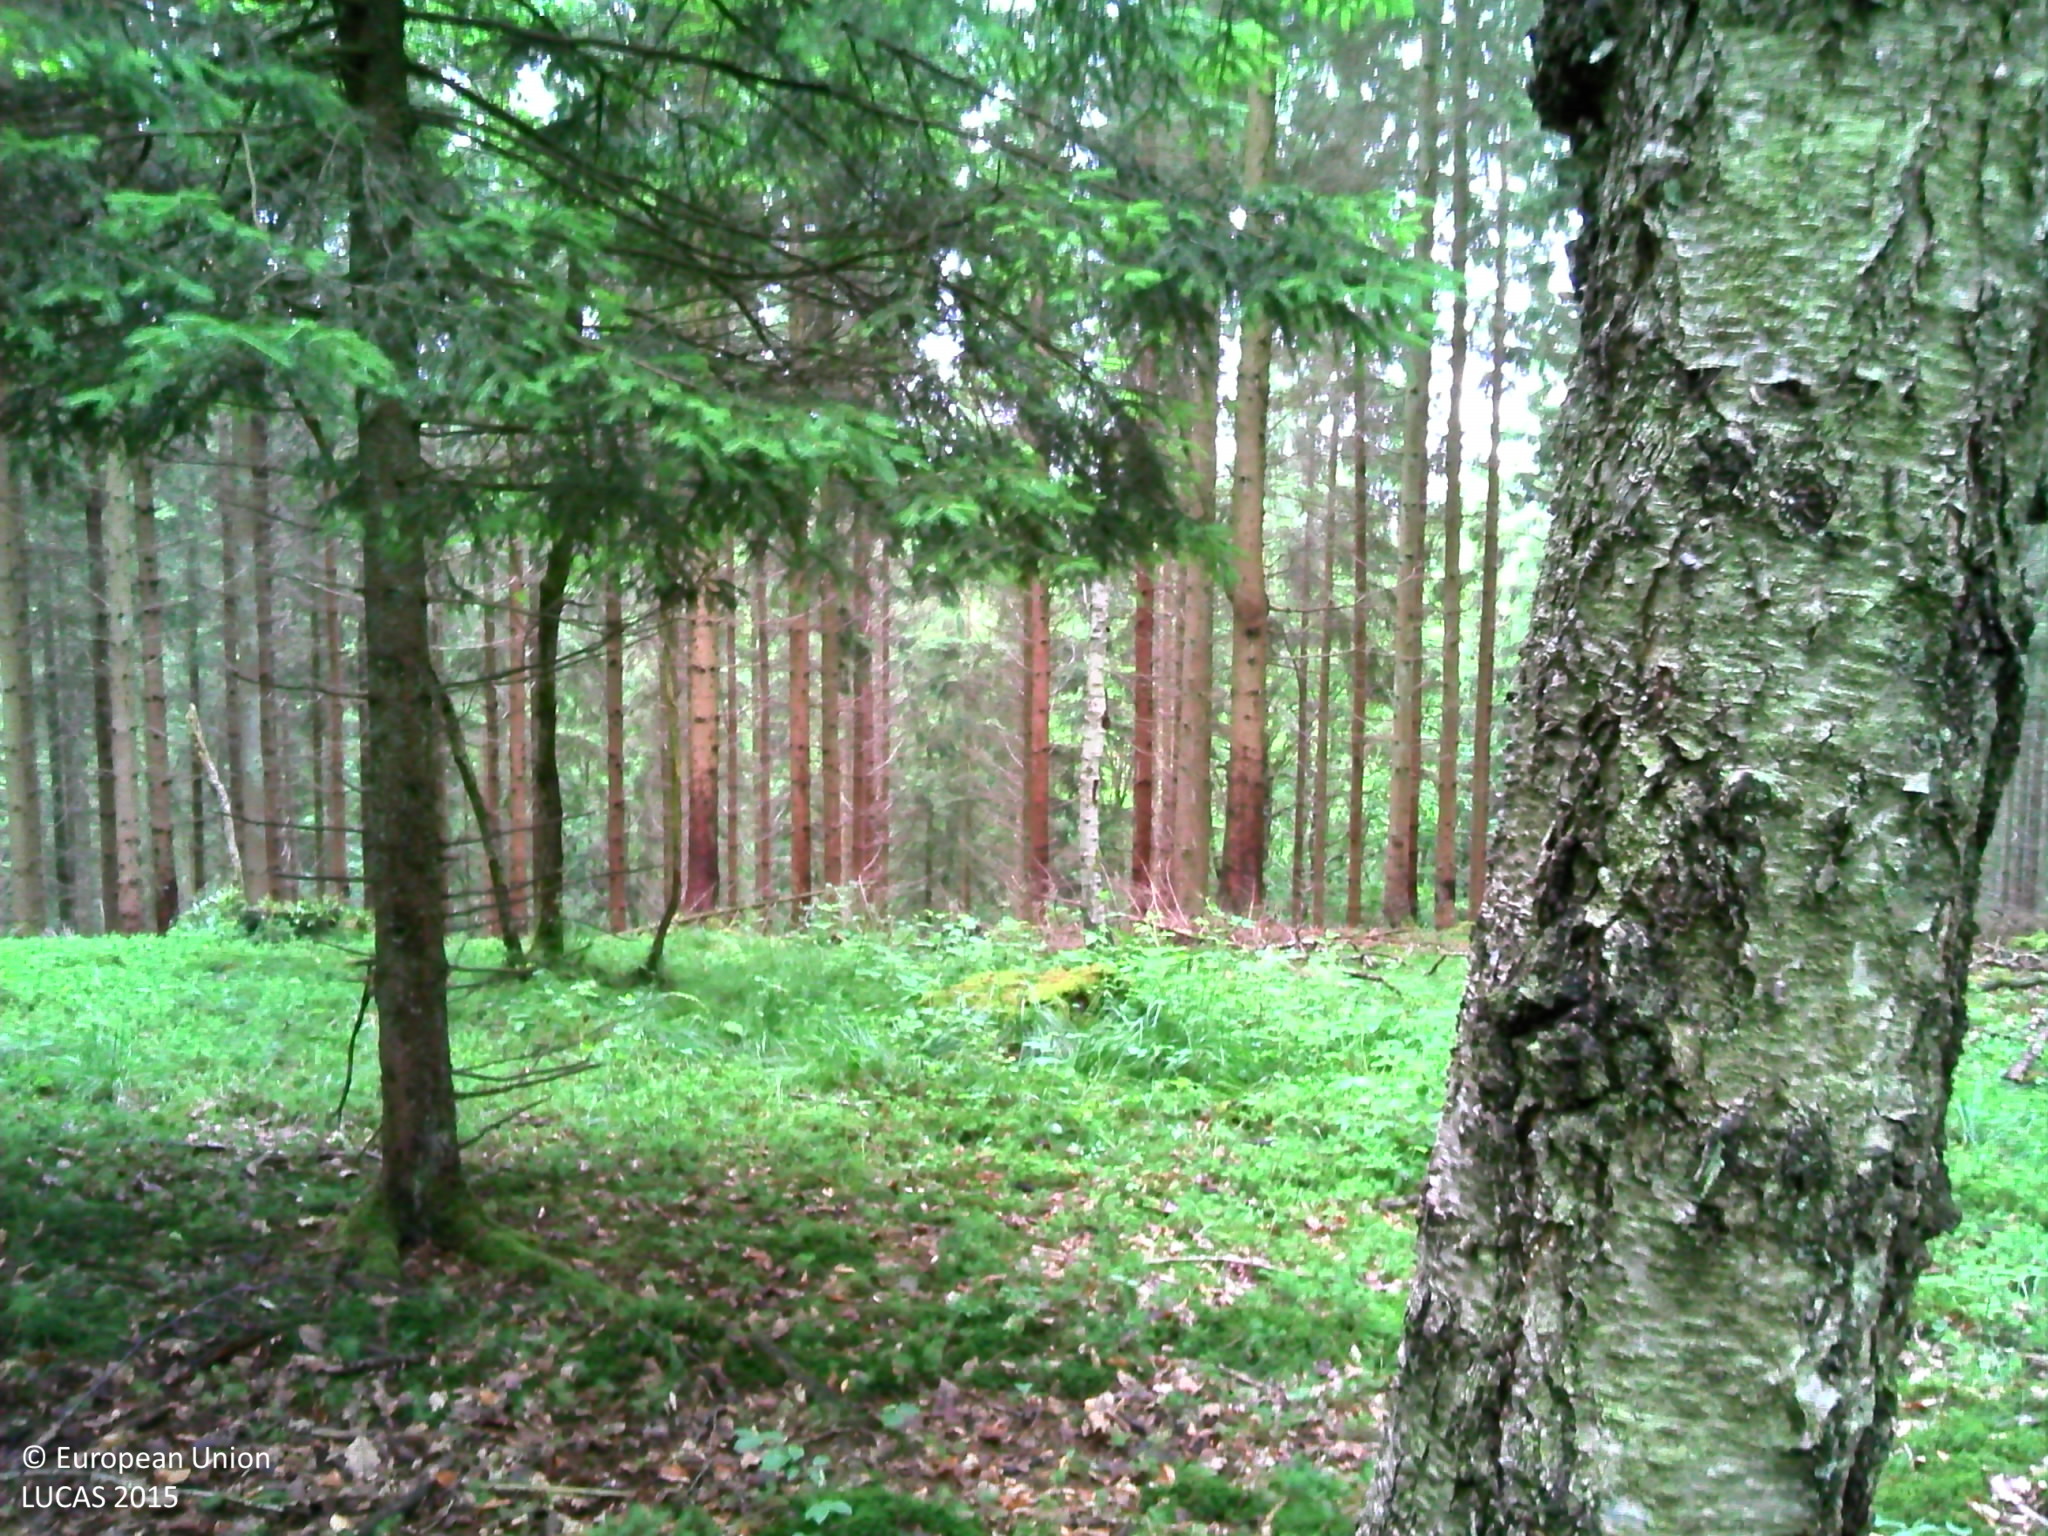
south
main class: Woodland
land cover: Broadleaved woodland
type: acidophilous oak and oak-birch forest
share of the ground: > 75 %
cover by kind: broadleaved forest trees 85 %, coniferous forest trees 5 %, herbaceous plants 5 %, lichens and mosses 5 %
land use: Forestry
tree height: > 5 m
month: June
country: BE
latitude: 50.3335
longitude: 5.6011
